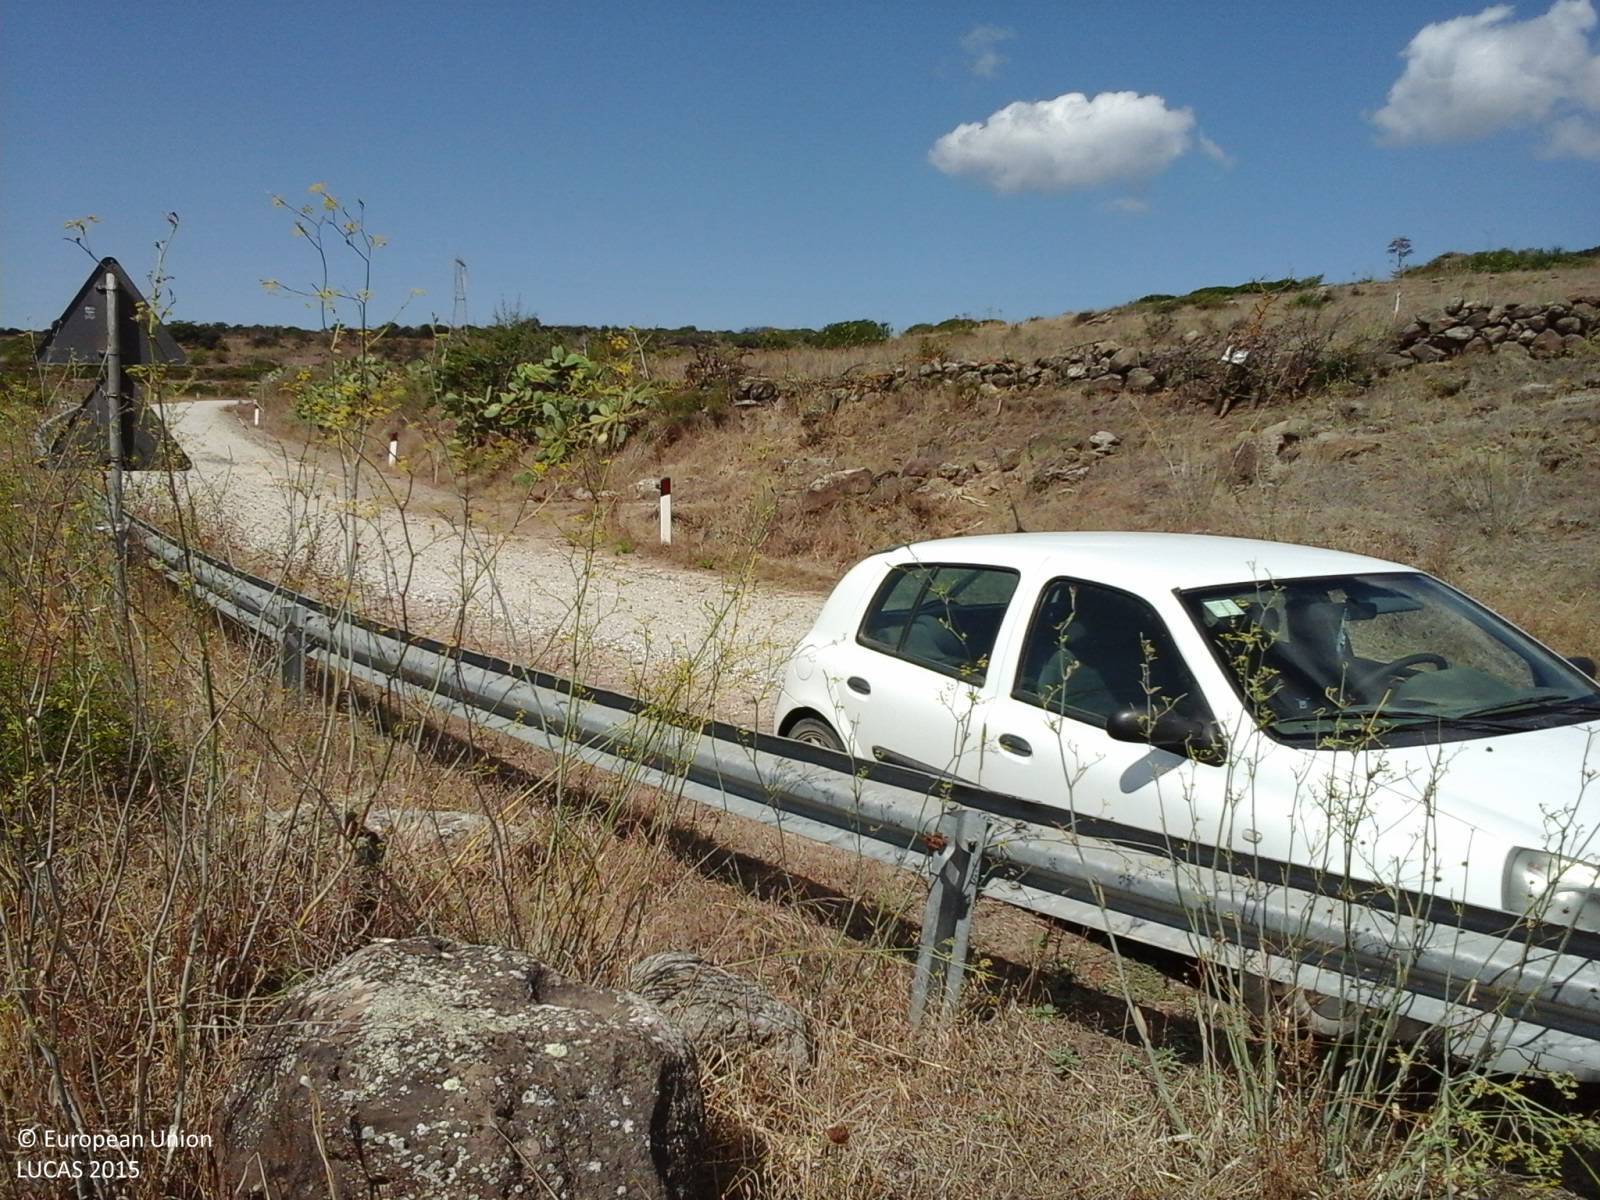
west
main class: Grassland
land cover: Grassland without tree/shrub cover
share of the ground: > 75 %
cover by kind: herbaceous plants 100 %
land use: Agriculture (excluding fallow land and kitchen gardens)
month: August
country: IT
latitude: 40.1341
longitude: 8.8676
